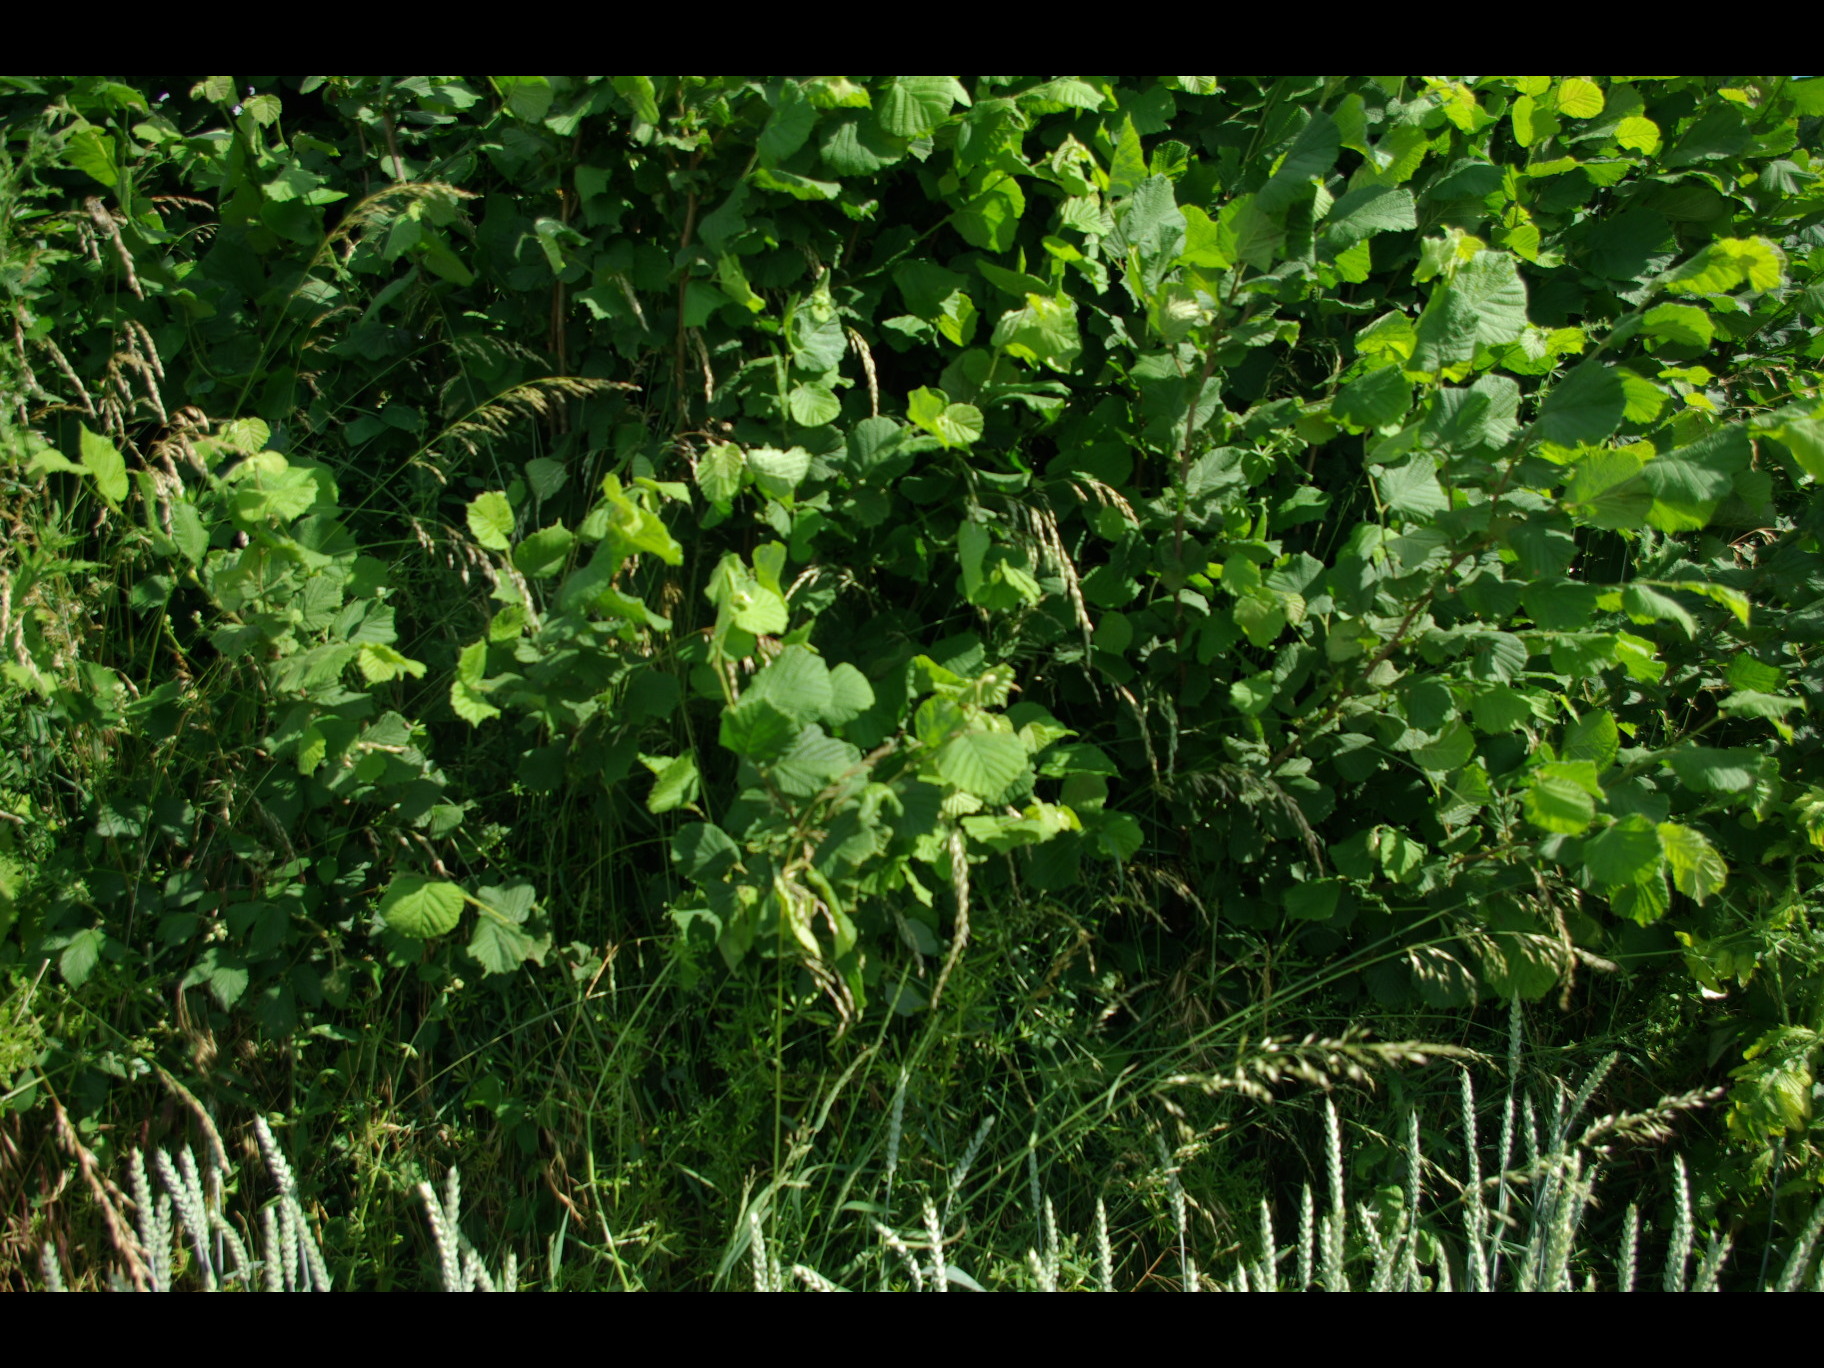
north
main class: Cropland
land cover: Common wheat
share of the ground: > 75 %
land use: Agriculture (excluding fallow land and kitchen gardens)
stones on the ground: 25 - 50 %
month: July
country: DE
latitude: 54.5516
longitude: 9.6446
